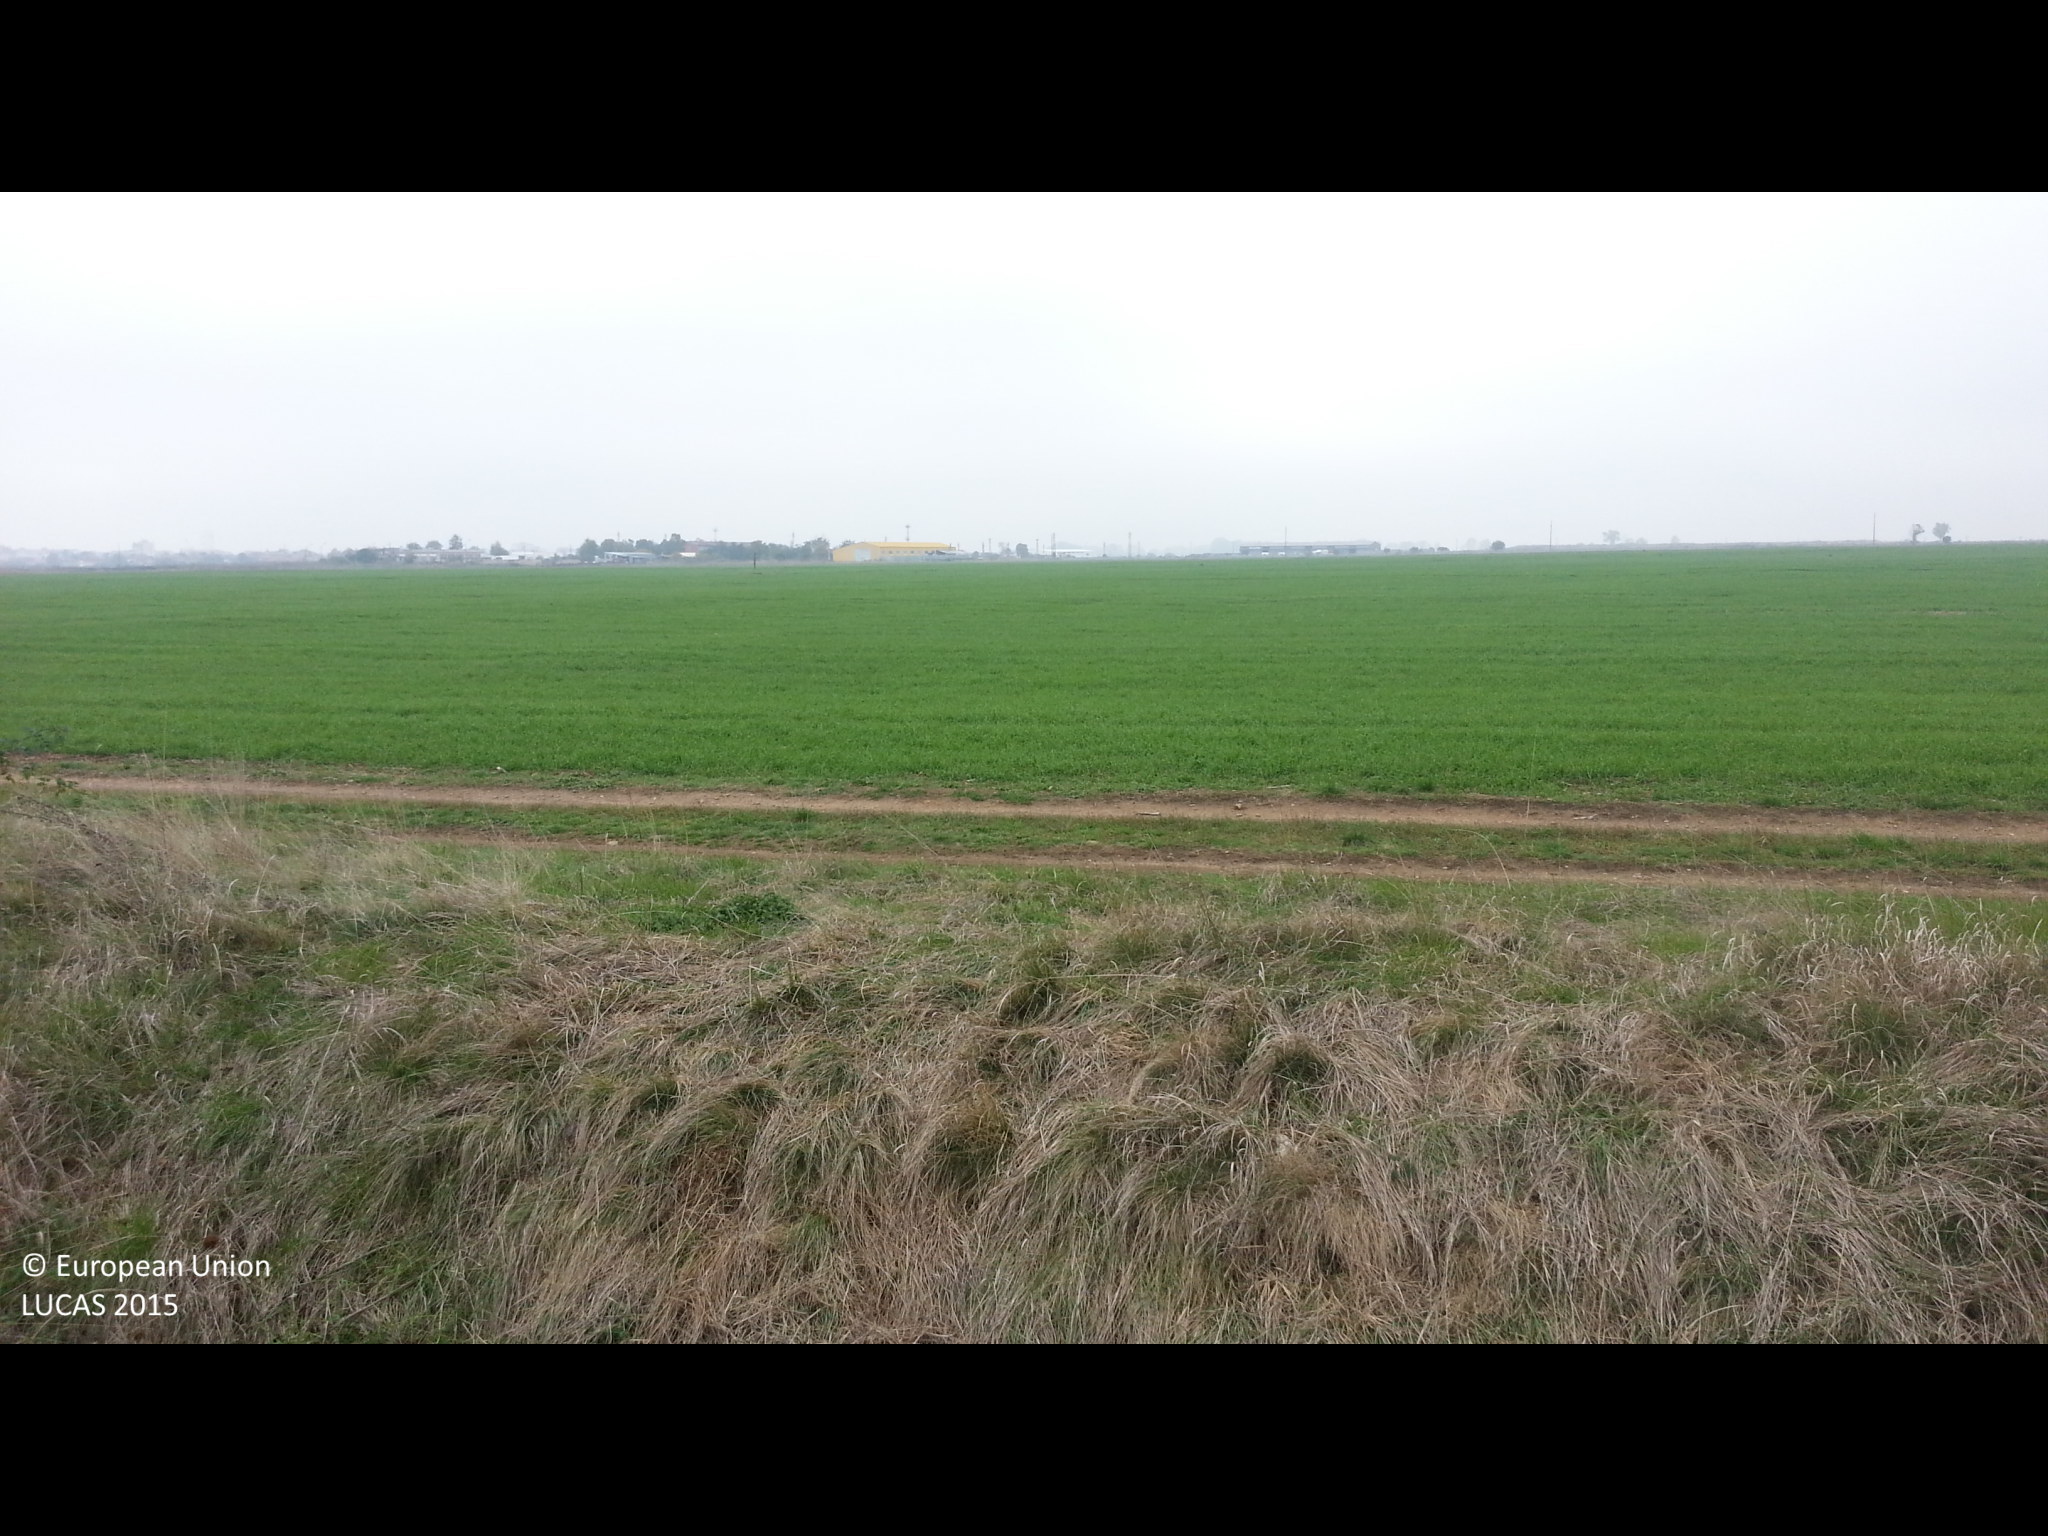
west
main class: Grassland
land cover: Grassland with sparse tree/shrub cover
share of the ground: > 75 %
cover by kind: herbaceous plants 90 %, broadleaved forest trees 5 %, shrubs 5 %
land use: Semi-natural and natural areas not in use
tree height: < 5 m
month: October
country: BG
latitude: 42.6799
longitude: 23.6211
